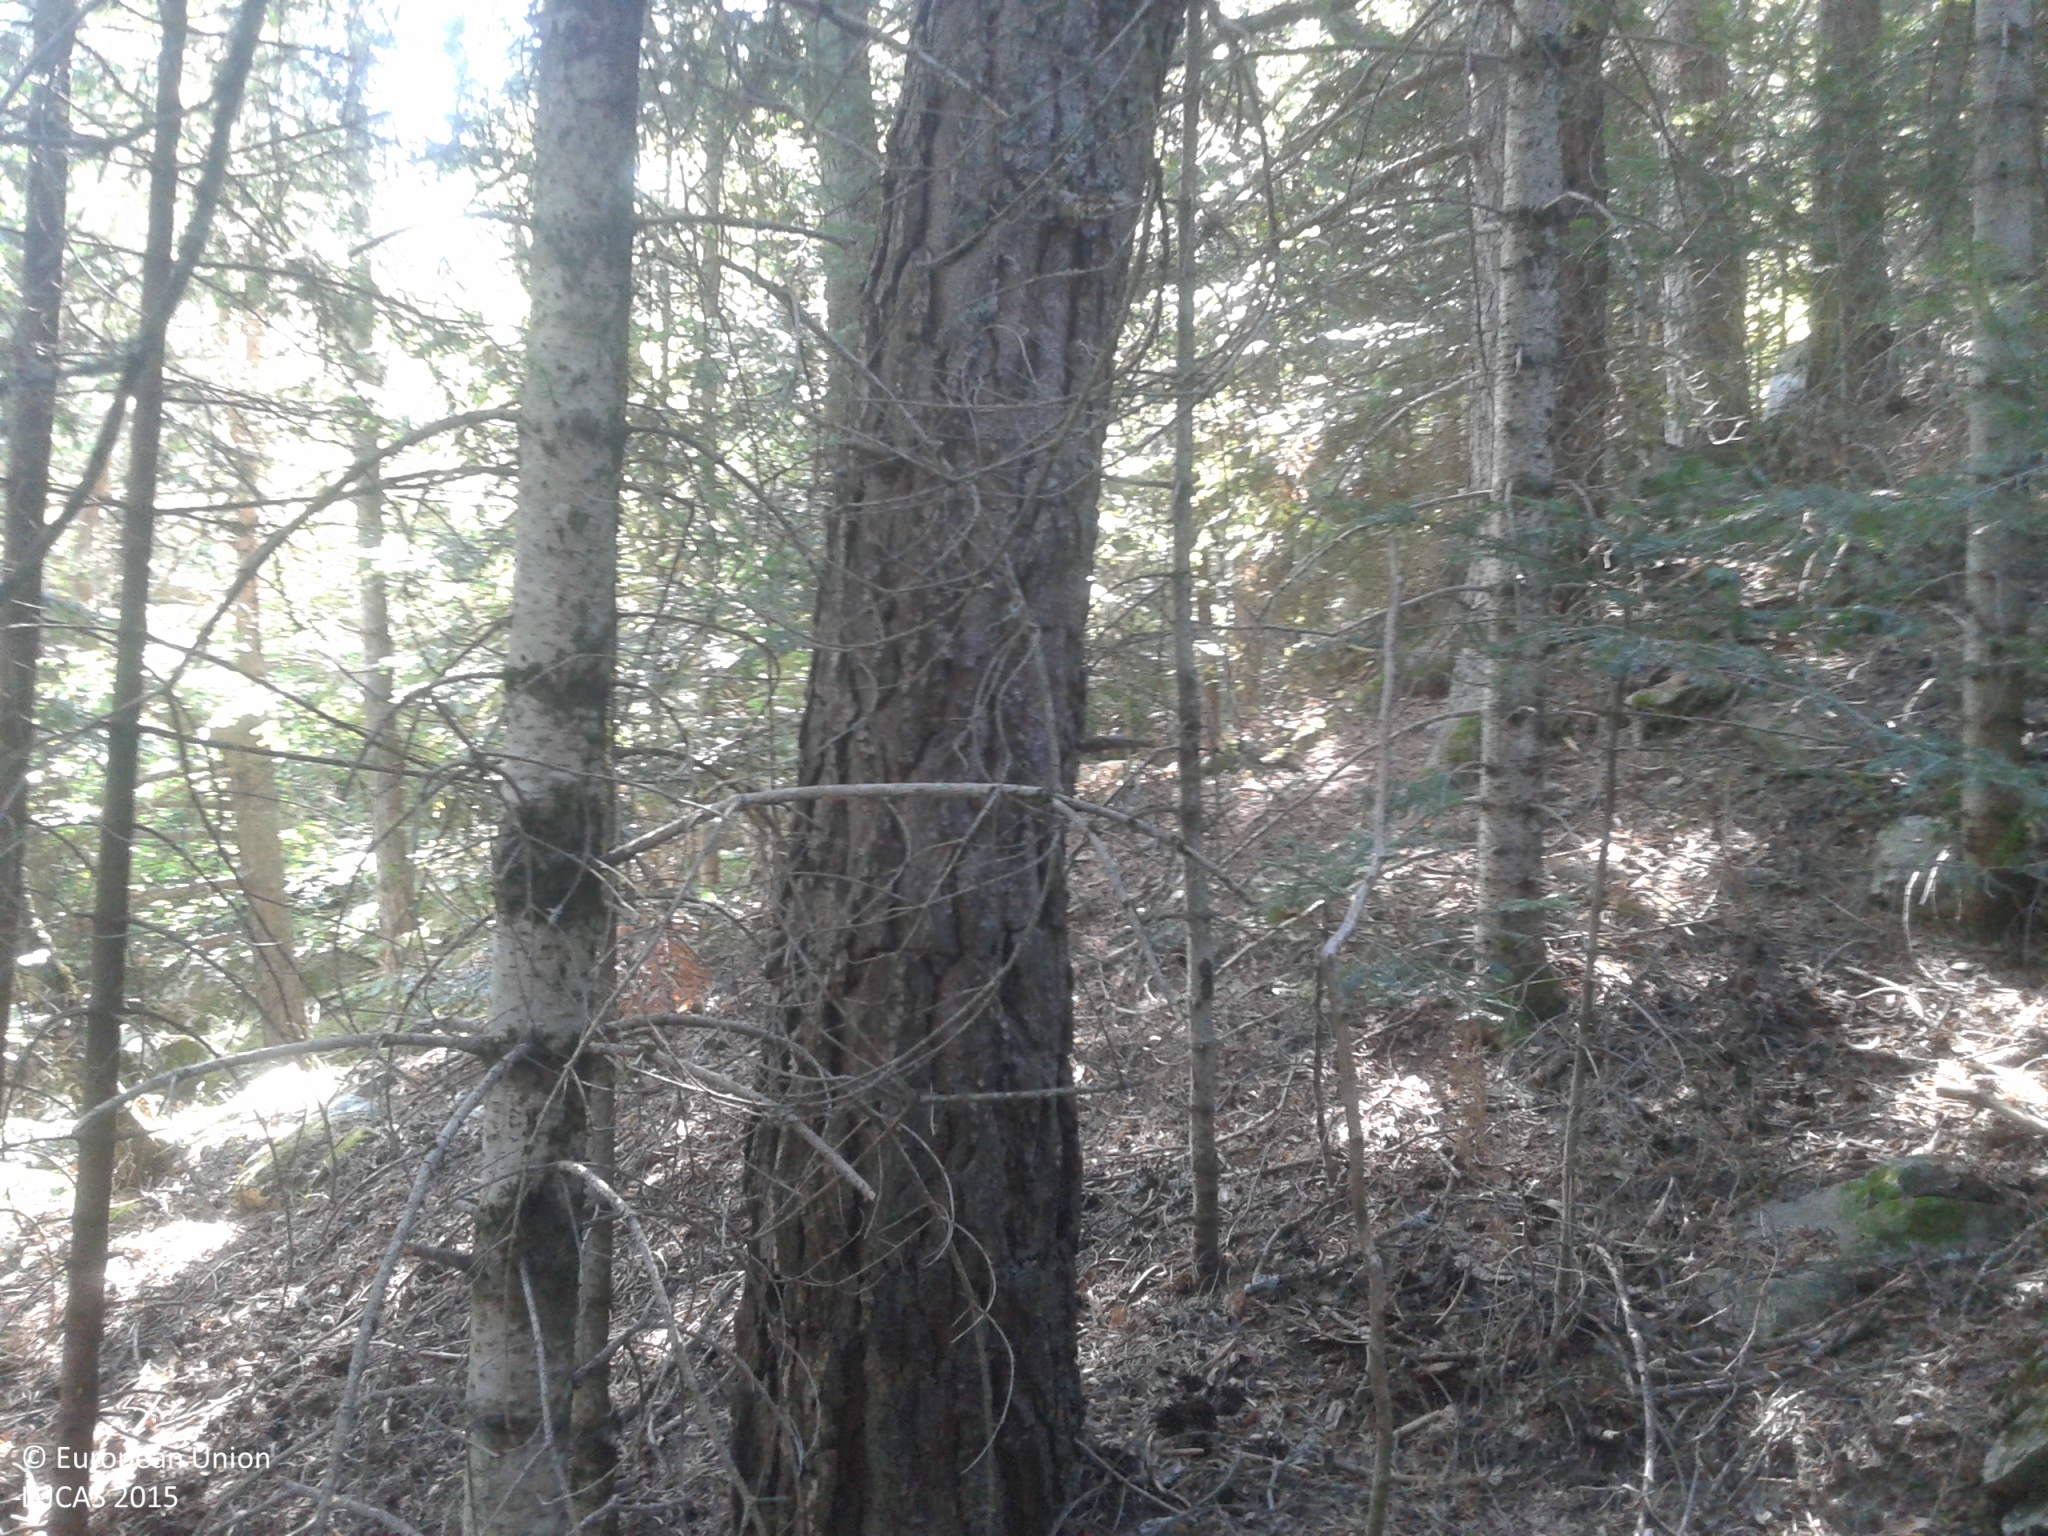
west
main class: Woodland
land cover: Pine dominated coniferous woodland
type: alpine coniferous forest
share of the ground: > 75 %
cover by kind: coniferous forest trees 90 %, broadleaved forest trees 5 %, herbaceous plants 5 %
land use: Semi-natural and natural areas not in use
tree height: > 5 m
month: July
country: ES
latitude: 42.5819
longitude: 1.0269
